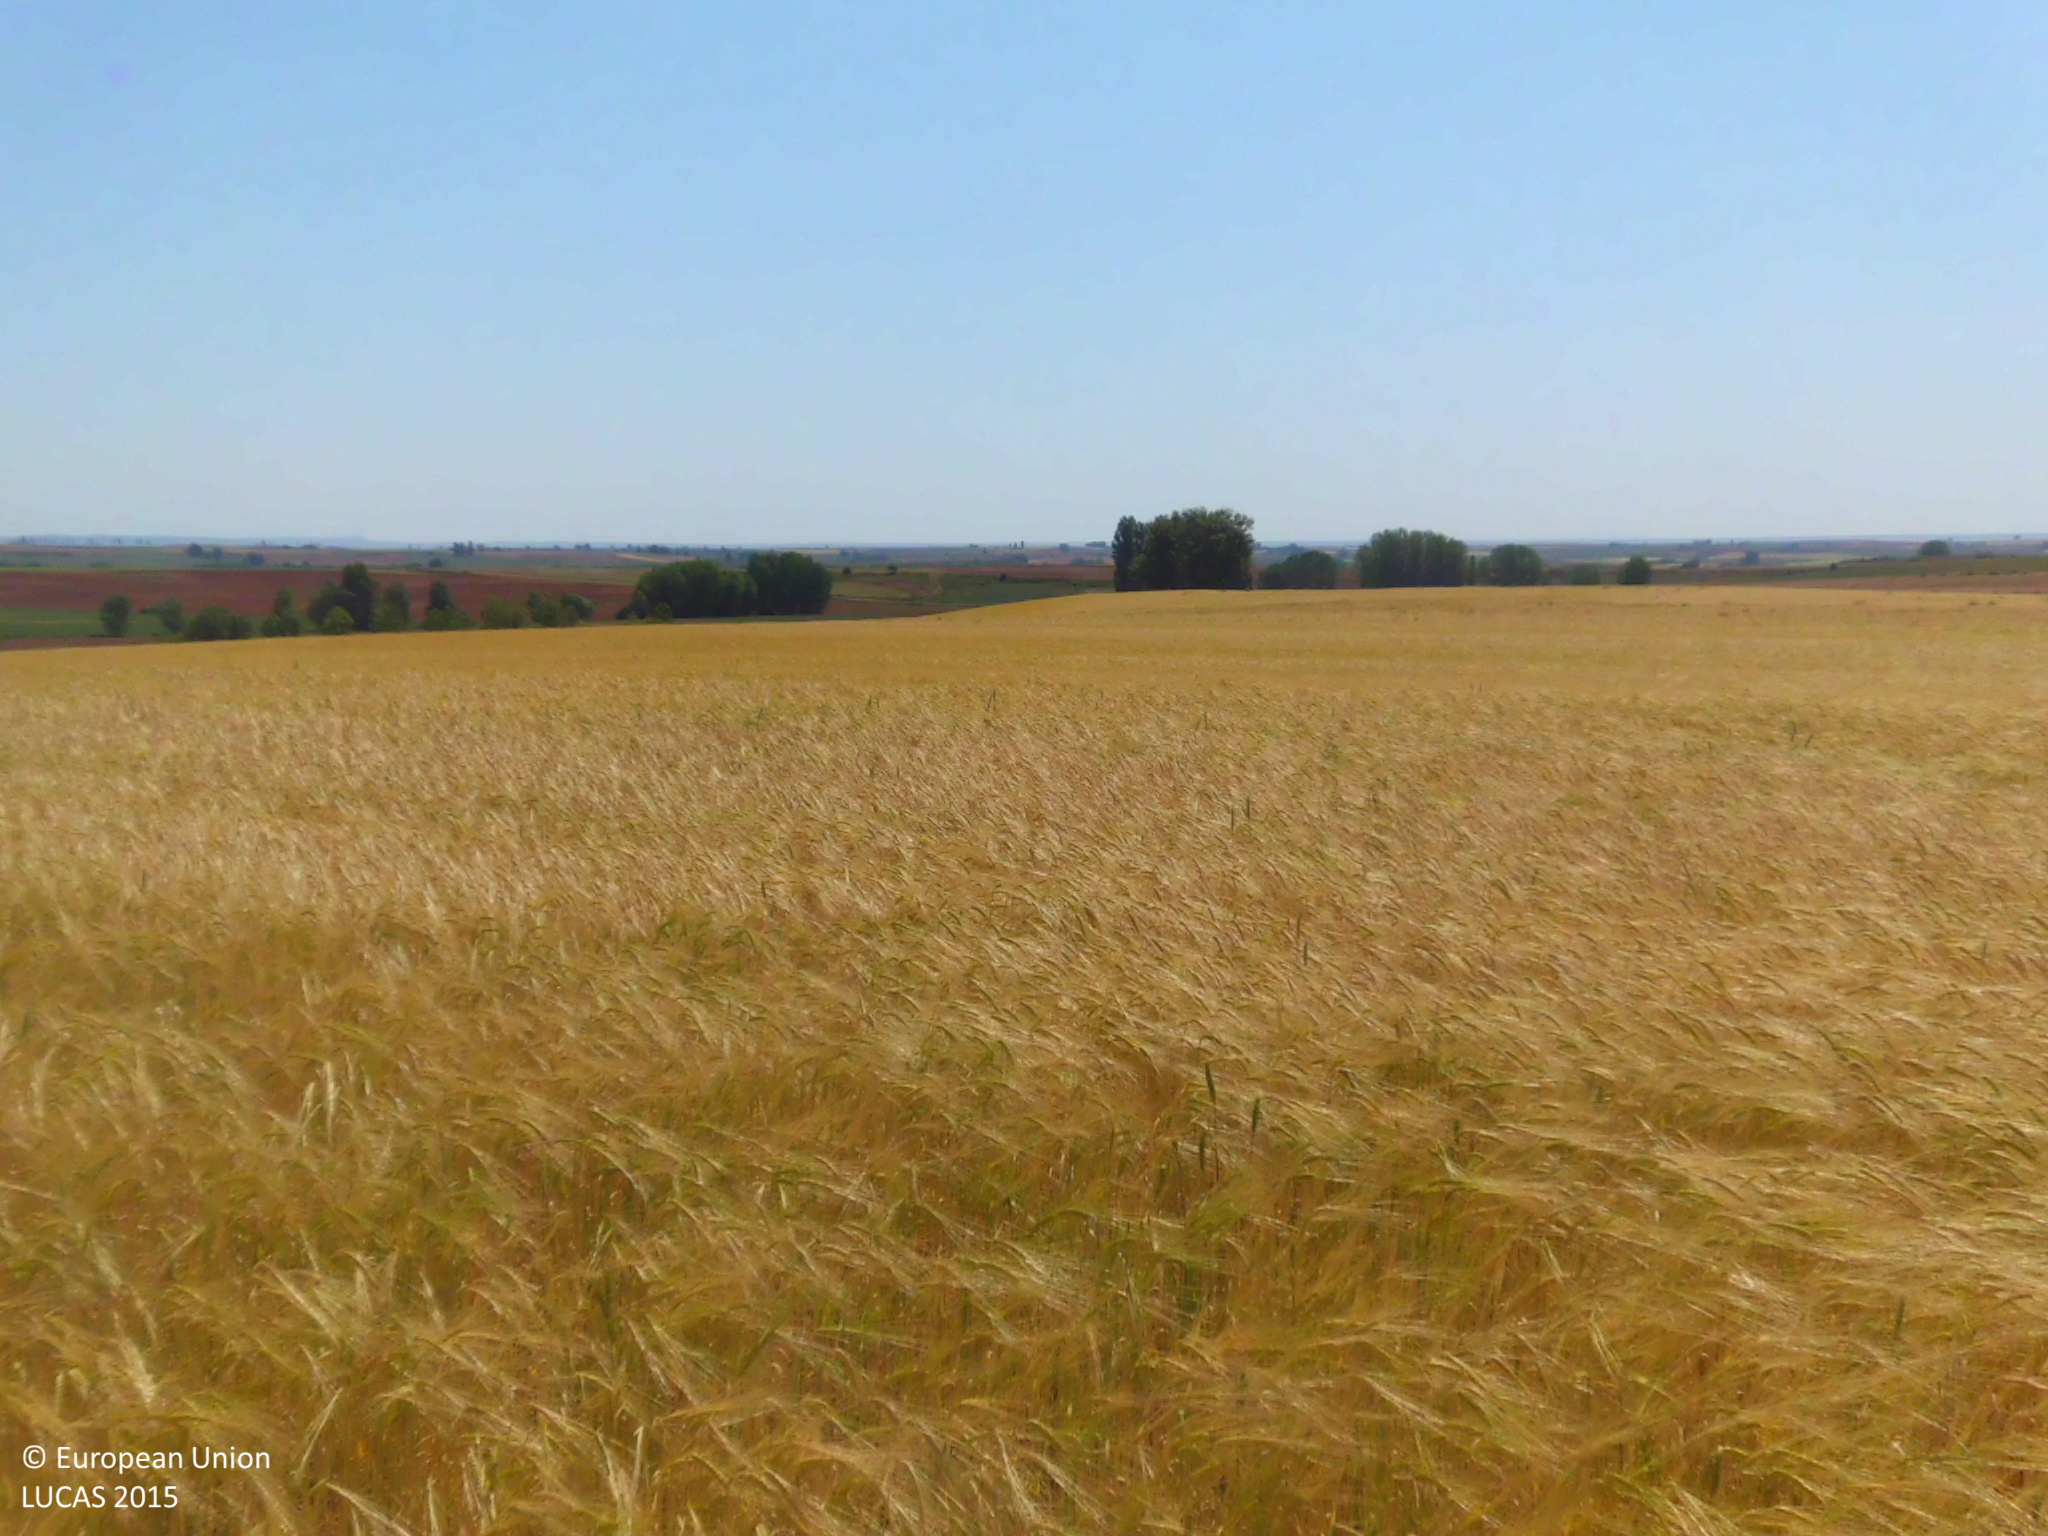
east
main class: Cropland
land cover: Barley
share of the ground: > 75 %
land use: Agriculture (excluding fallow land and kitchen gardens)
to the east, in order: Barley; Groves; Sunflower
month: June
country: ES
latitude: 42.5402
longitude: -4.2323
